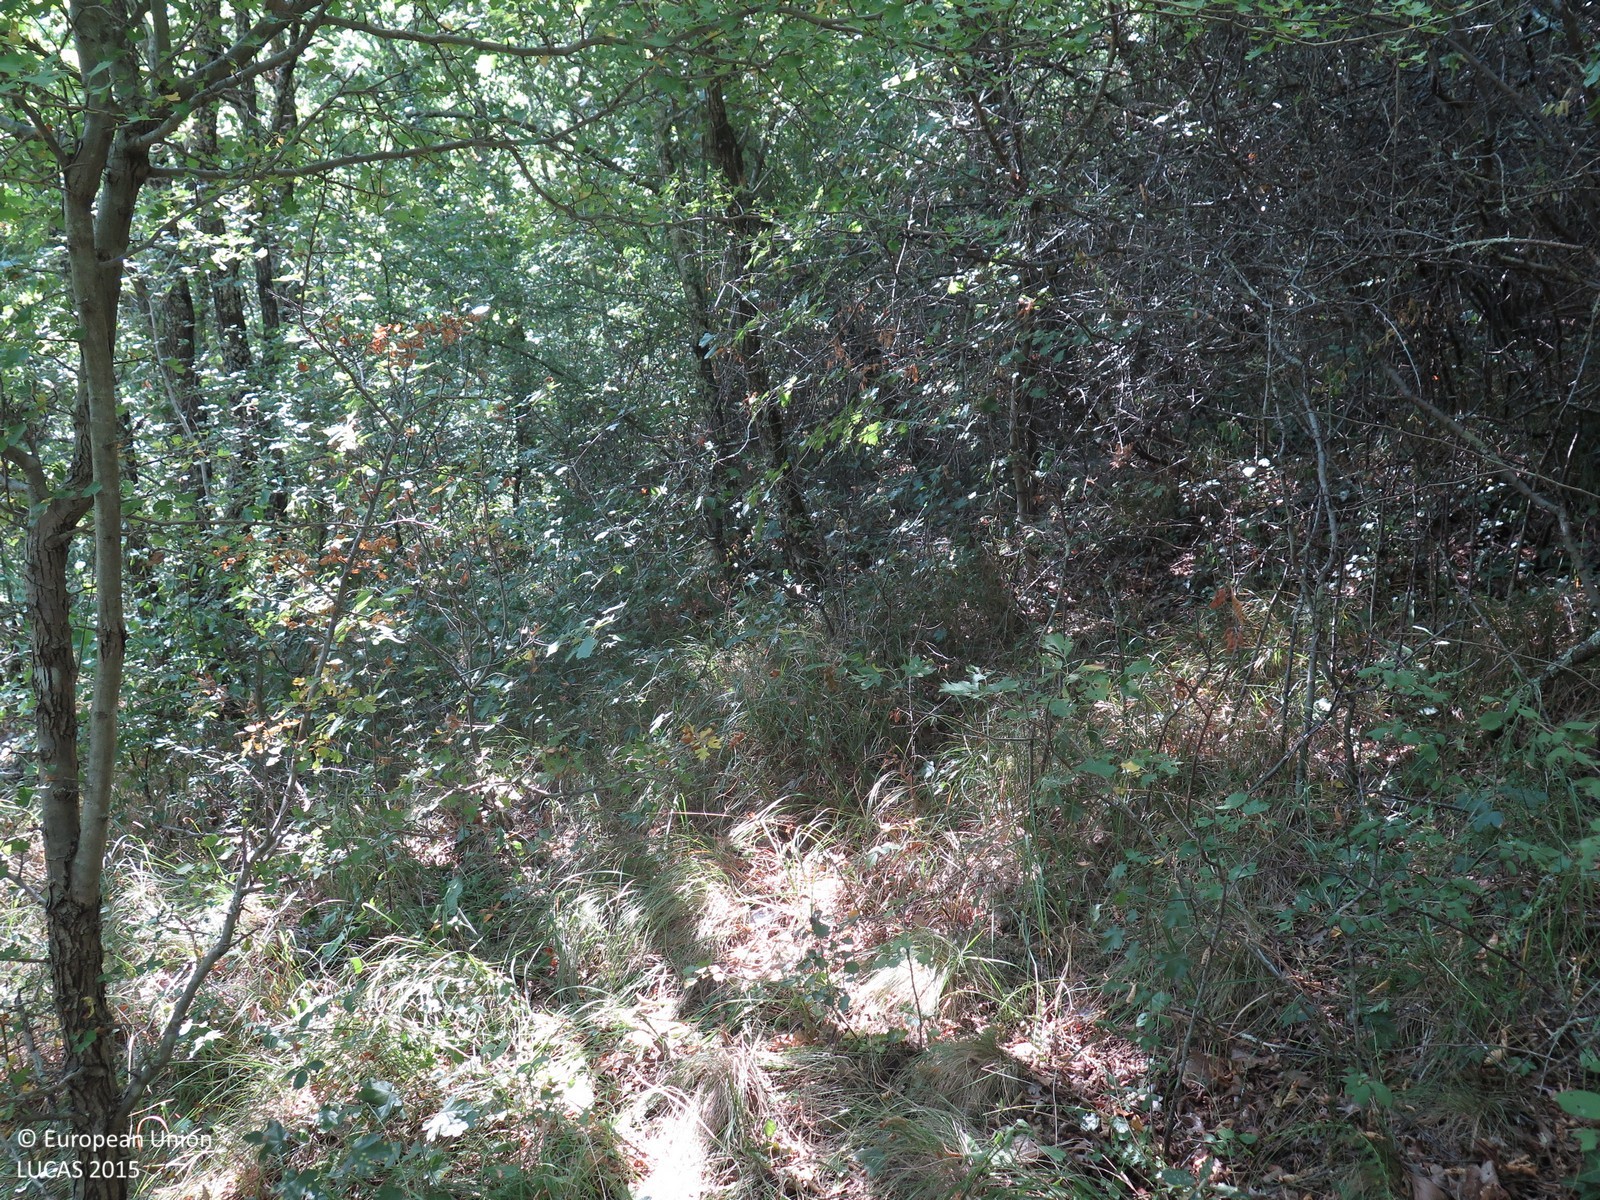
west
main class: Woodland
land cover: Broadleaved woodland
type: acidophilous oak and oak-birch forest
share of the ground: > 75 %
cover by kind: broadleaved forest trees 90 %, coniferous forest trees 5 %, herbaceous plants 5 %
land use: Semi-natural and natural areas not in use
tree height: > 5 m
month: July
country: HR
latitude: 45.4372
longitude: 13.7663
